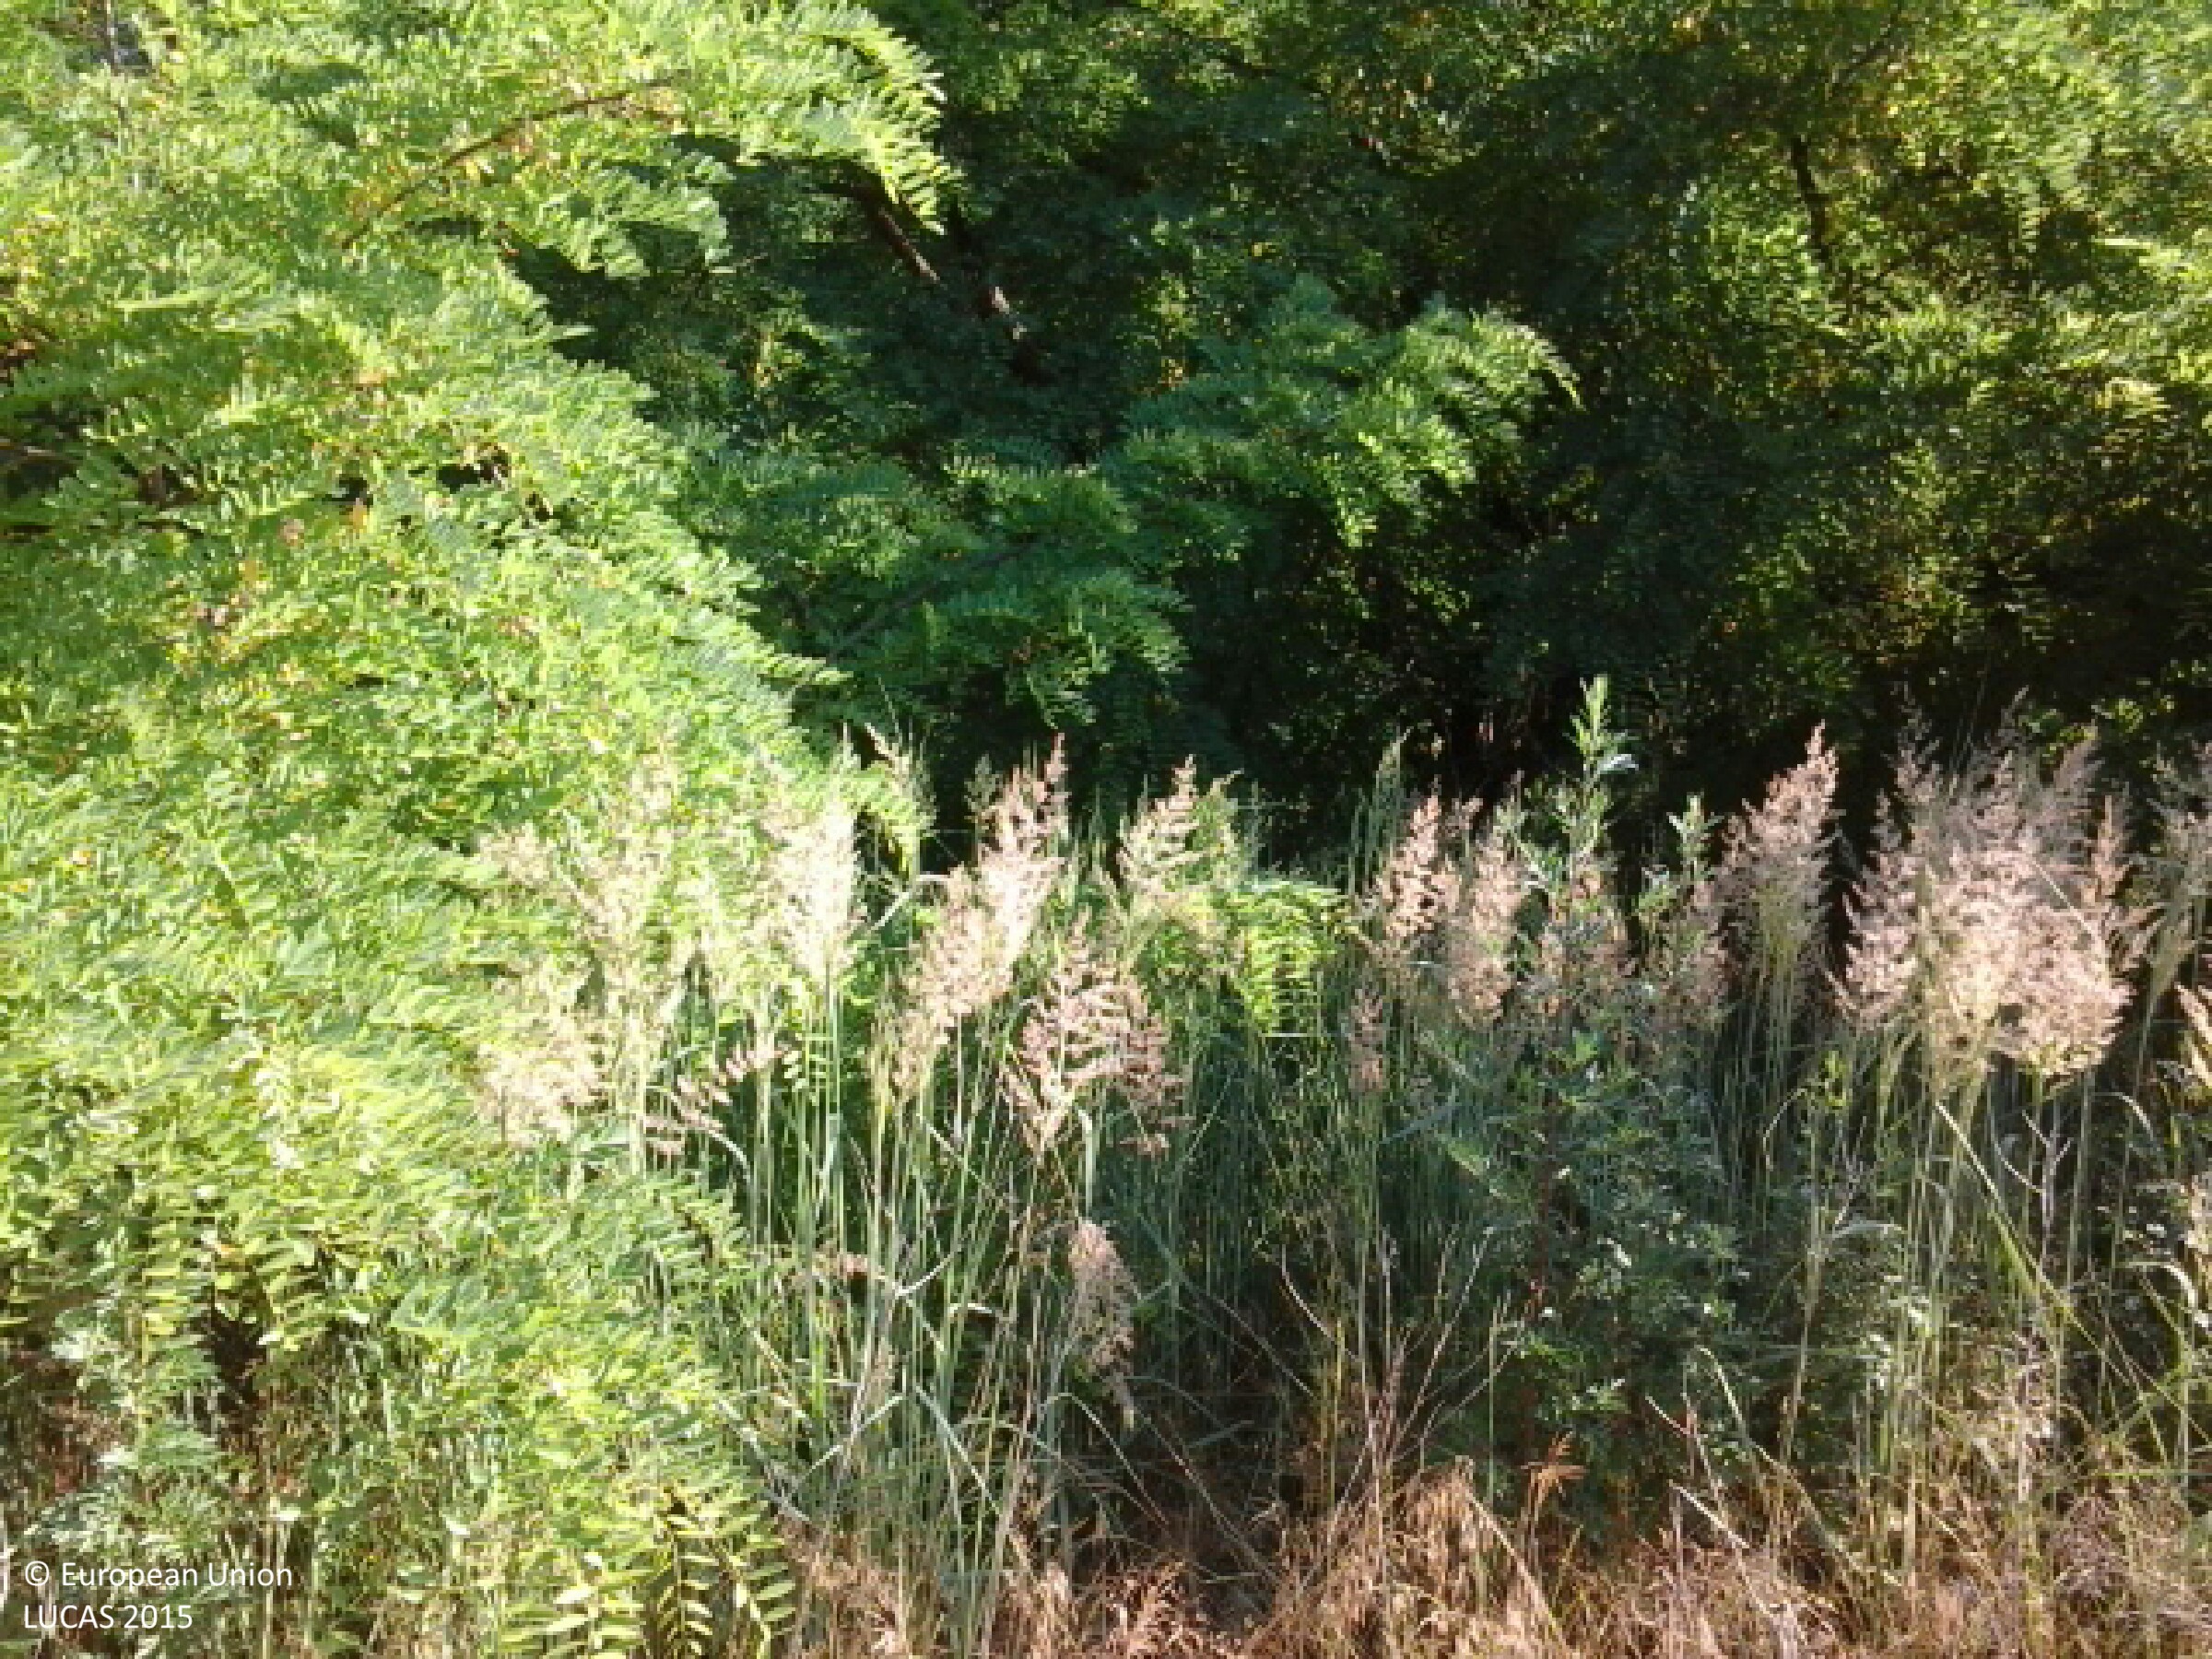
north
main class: Cropland
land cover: Oats
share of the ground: 50 - 75 %
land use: Agriculture (excluding fallow land and kitchen gardens)
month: June
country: HU
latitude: 47.9987
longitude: 21.6943
